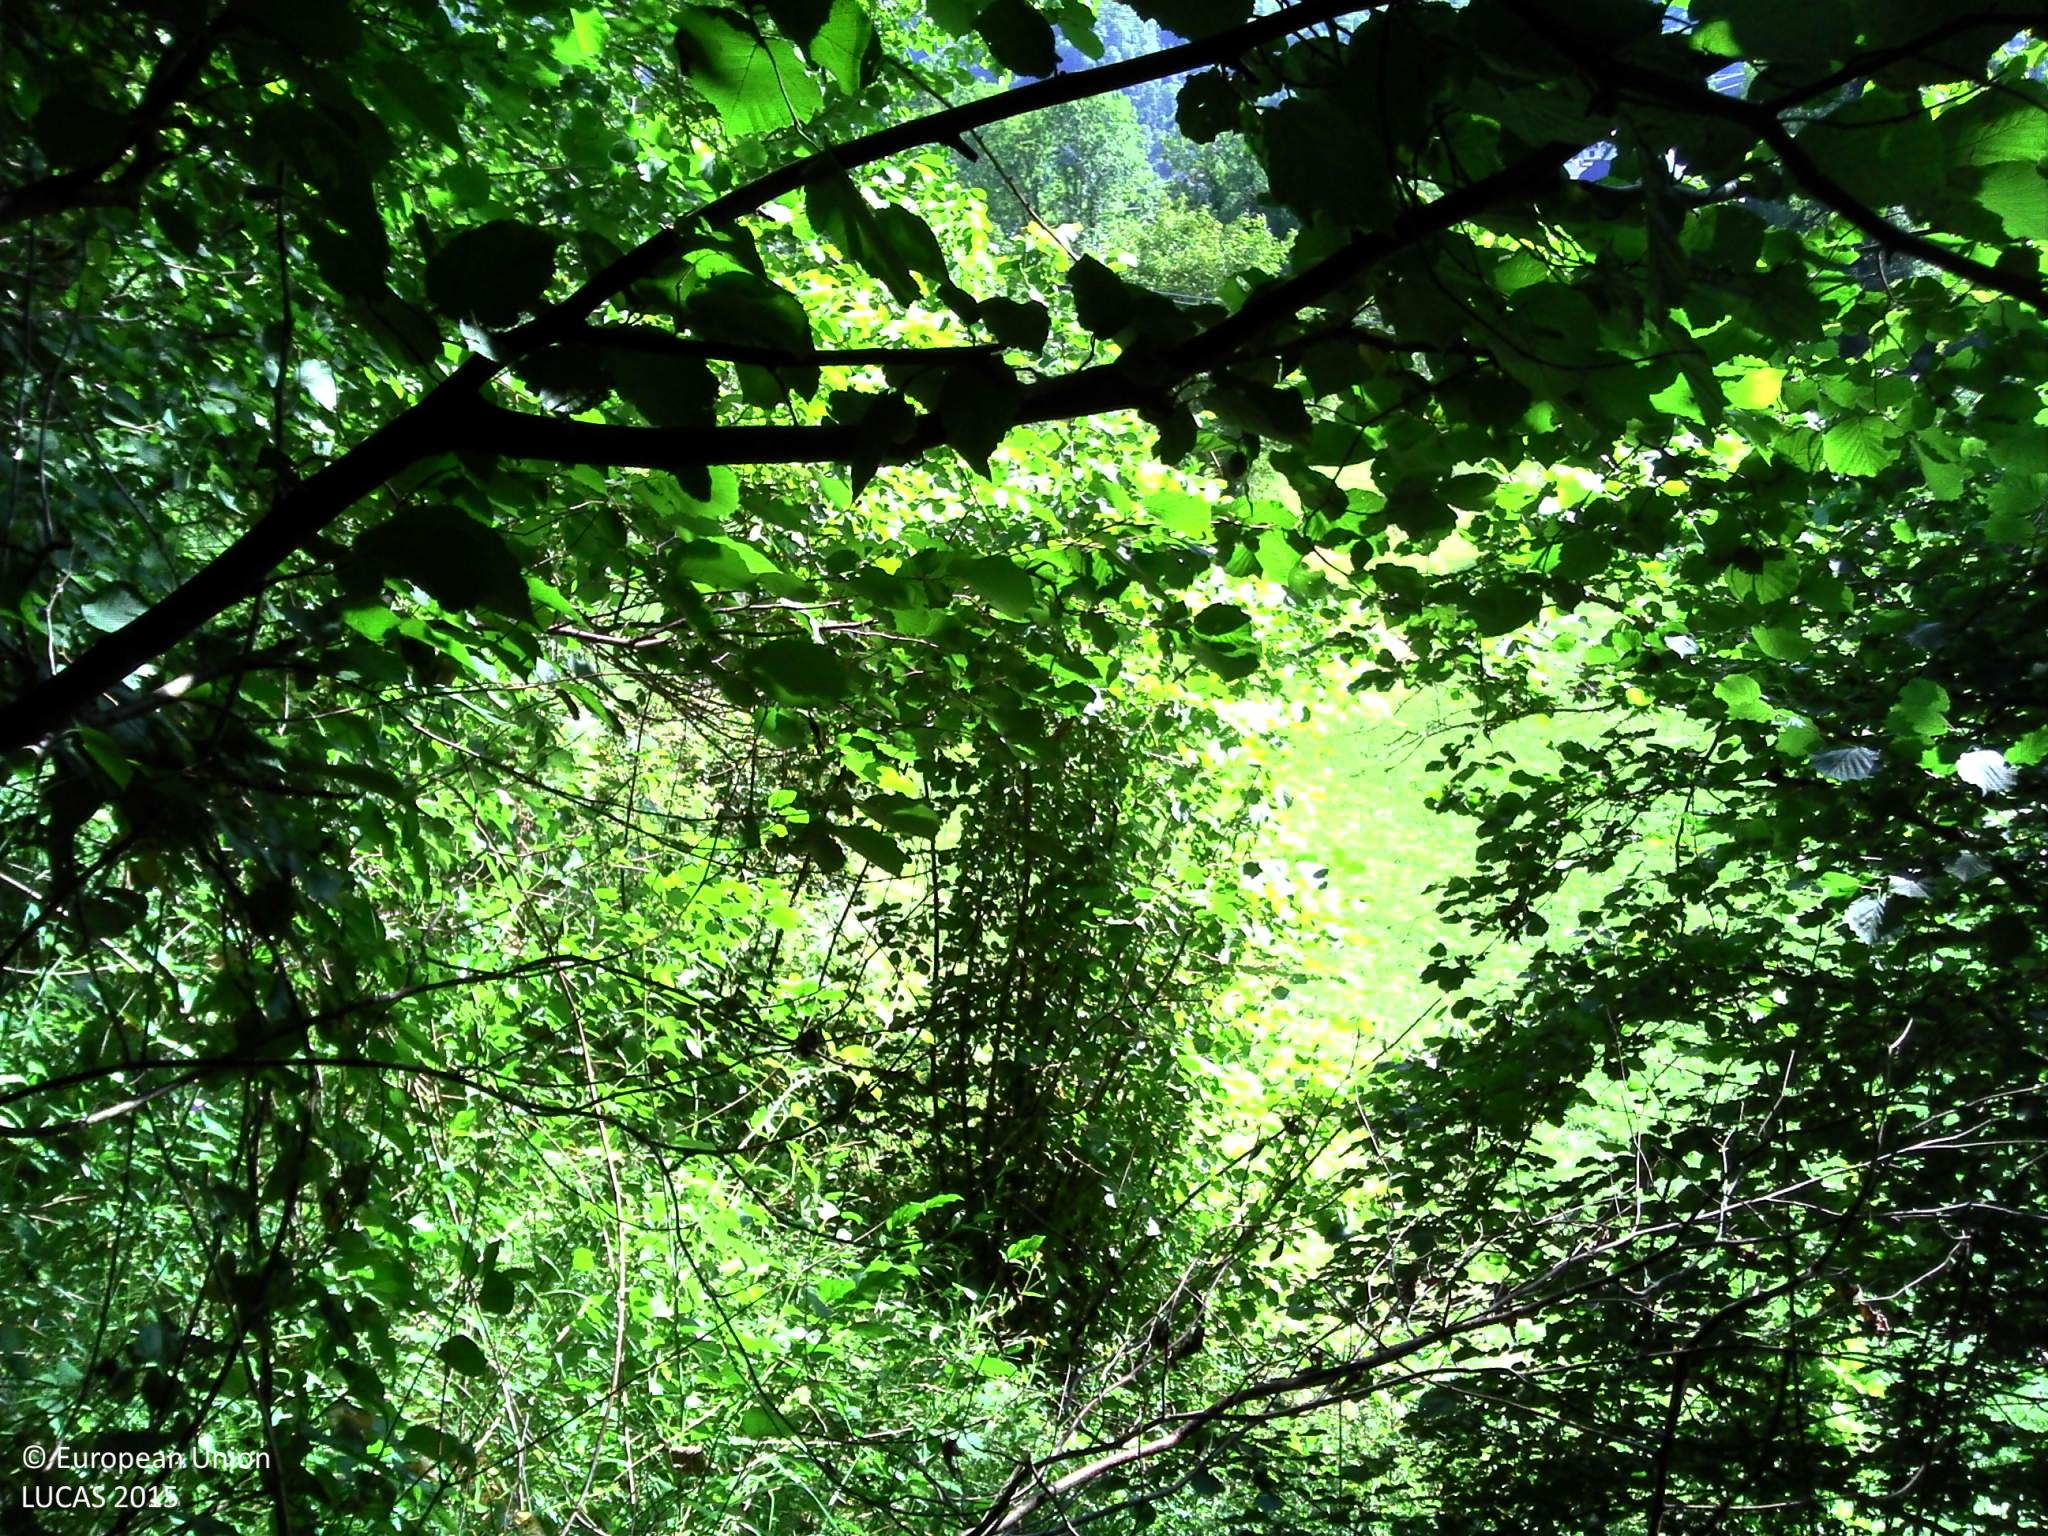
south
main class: Woodland
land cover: Broadleaved woodland
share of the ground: > 75 %
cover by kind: broadleaved forest trees 55 %, herbaceous plants 35 %, shrubs 10 %
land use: Agriculture (excluding fallow land and kitchen gardens)
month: July
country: FR
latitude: 42.9885
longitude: -0.4174
